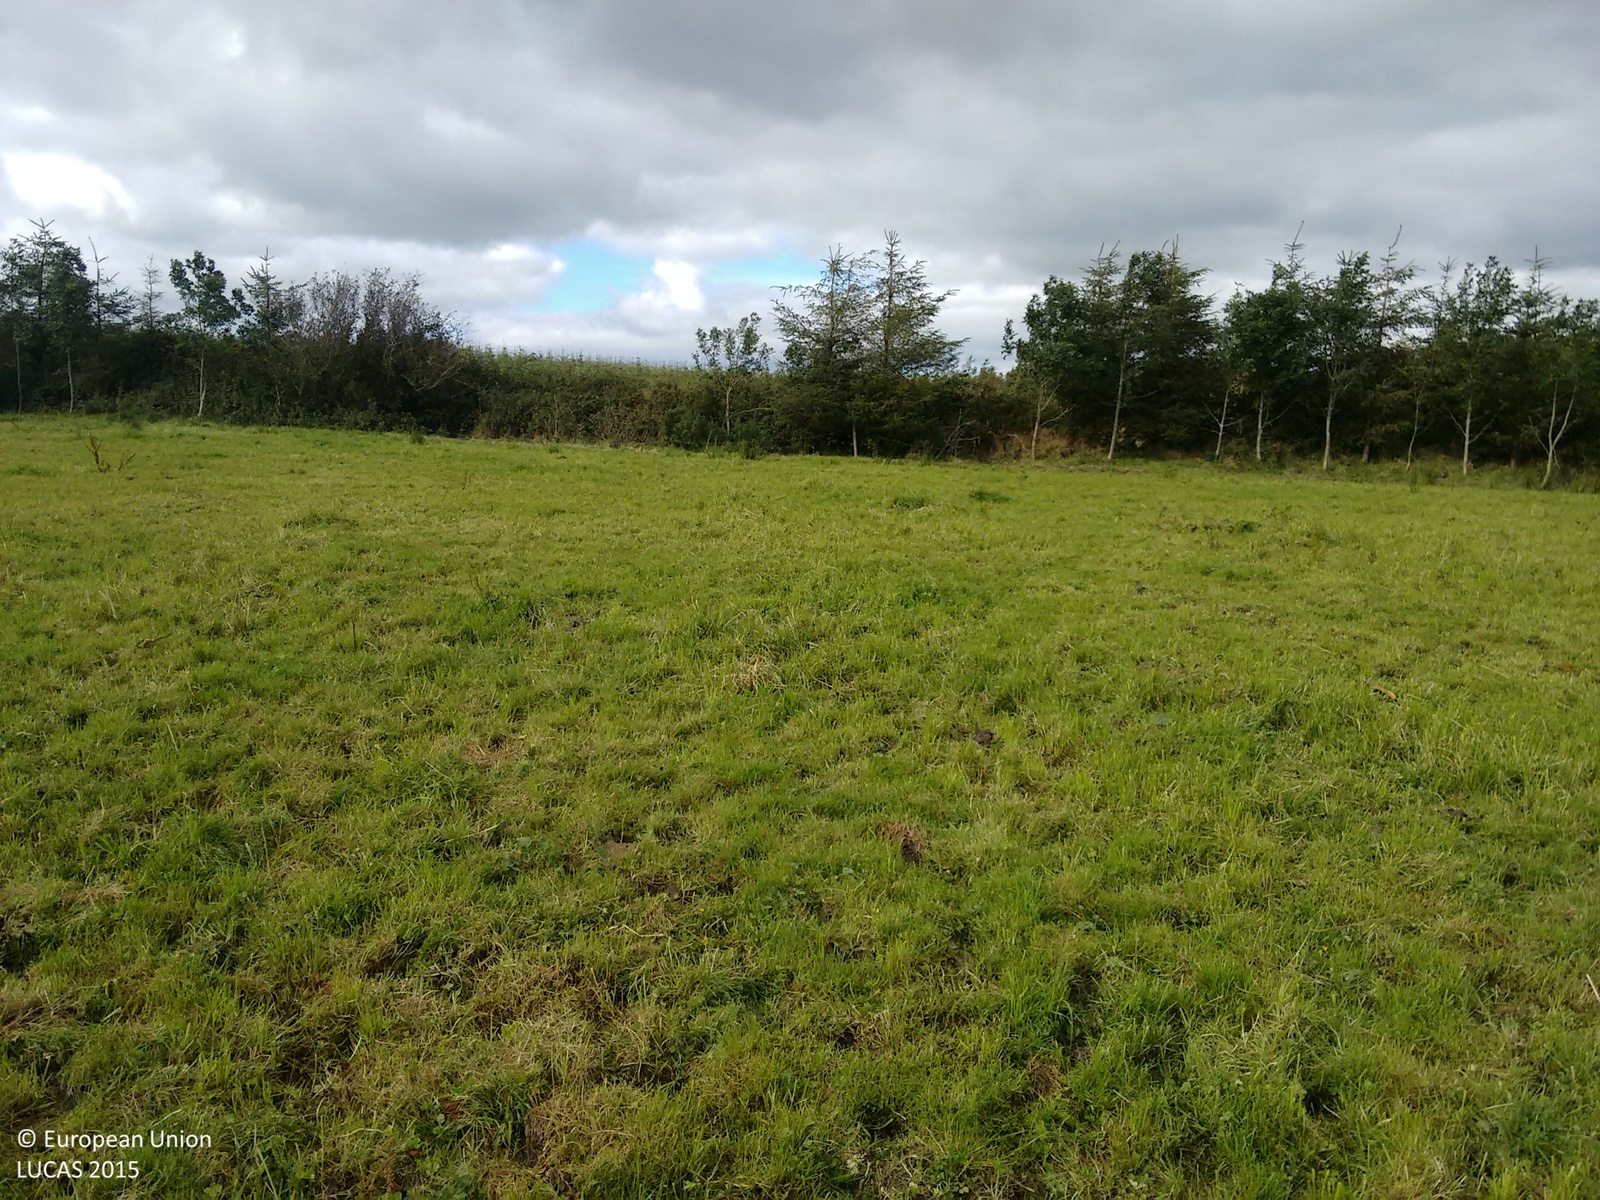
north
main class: Grassland
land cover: Grassland without tree/shrub cover
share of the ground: > 75 %
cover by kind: herbaceous plants 85 %, unconsolidated bare surface 10 %, shrubs 5 %
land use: Agriculture (excluding fallow land and kitchen gardens)
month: September
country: IE
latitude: 52.3272
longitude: -9.4072
